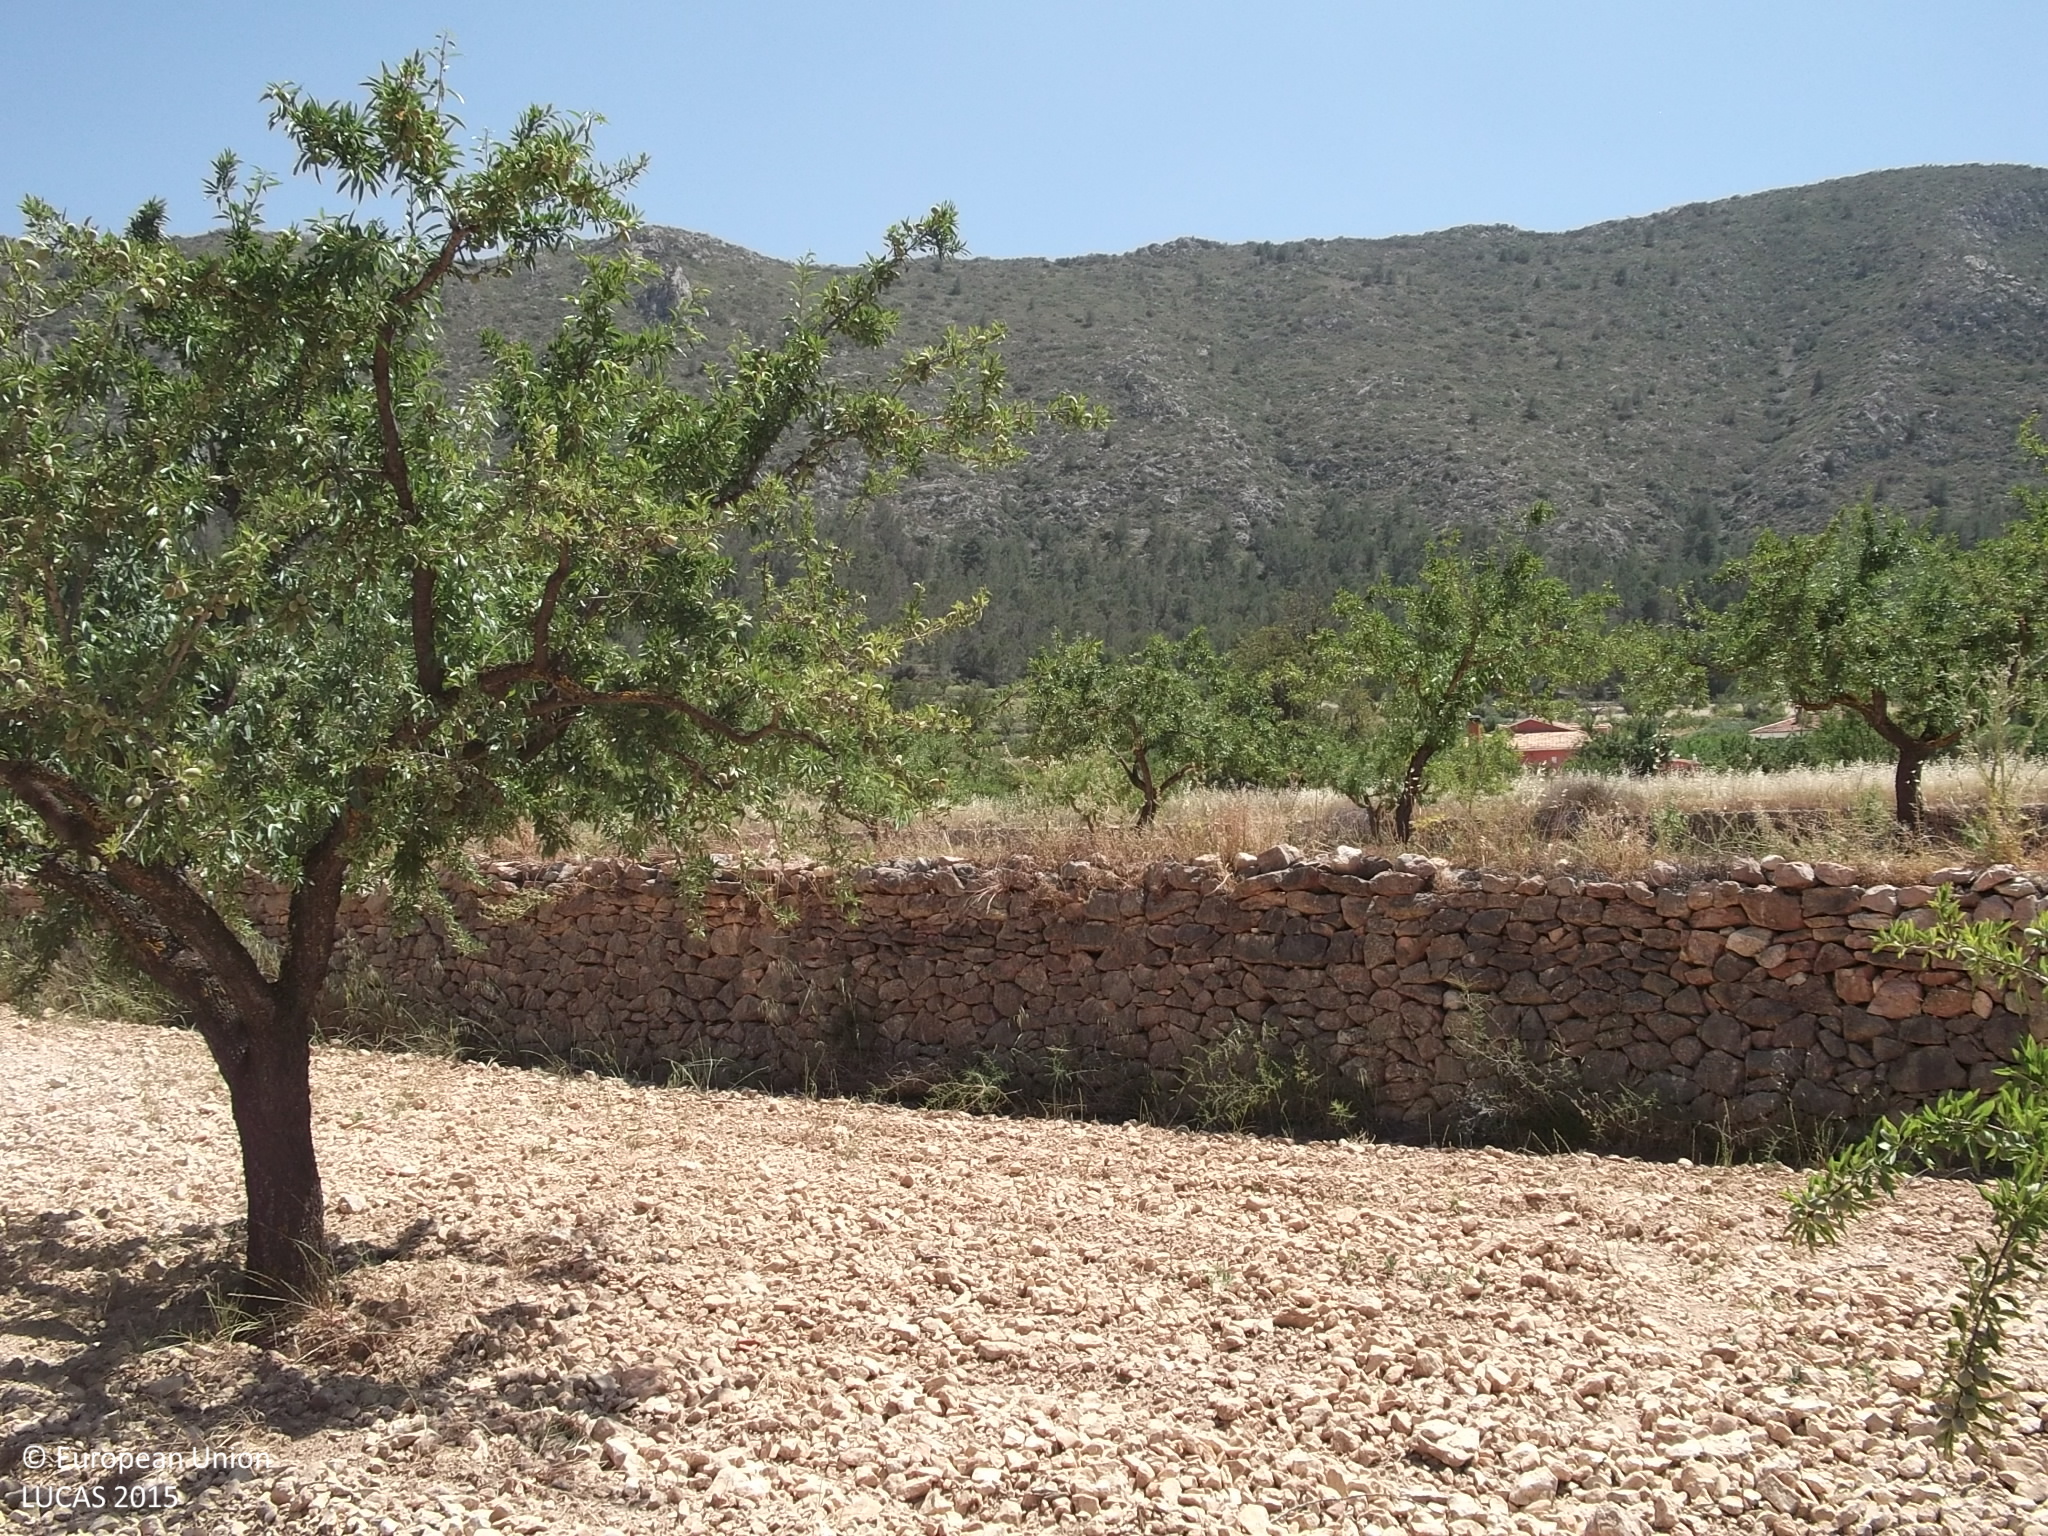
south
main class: Cropland
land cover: Nuts trees
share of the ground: 10 - 25 %
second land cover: Other bare soil
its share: > 75 %
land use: Agriculture (excluding fallow land and kitchen gardens)
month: May
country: ES
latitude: 38.3421
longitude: -0.9137
